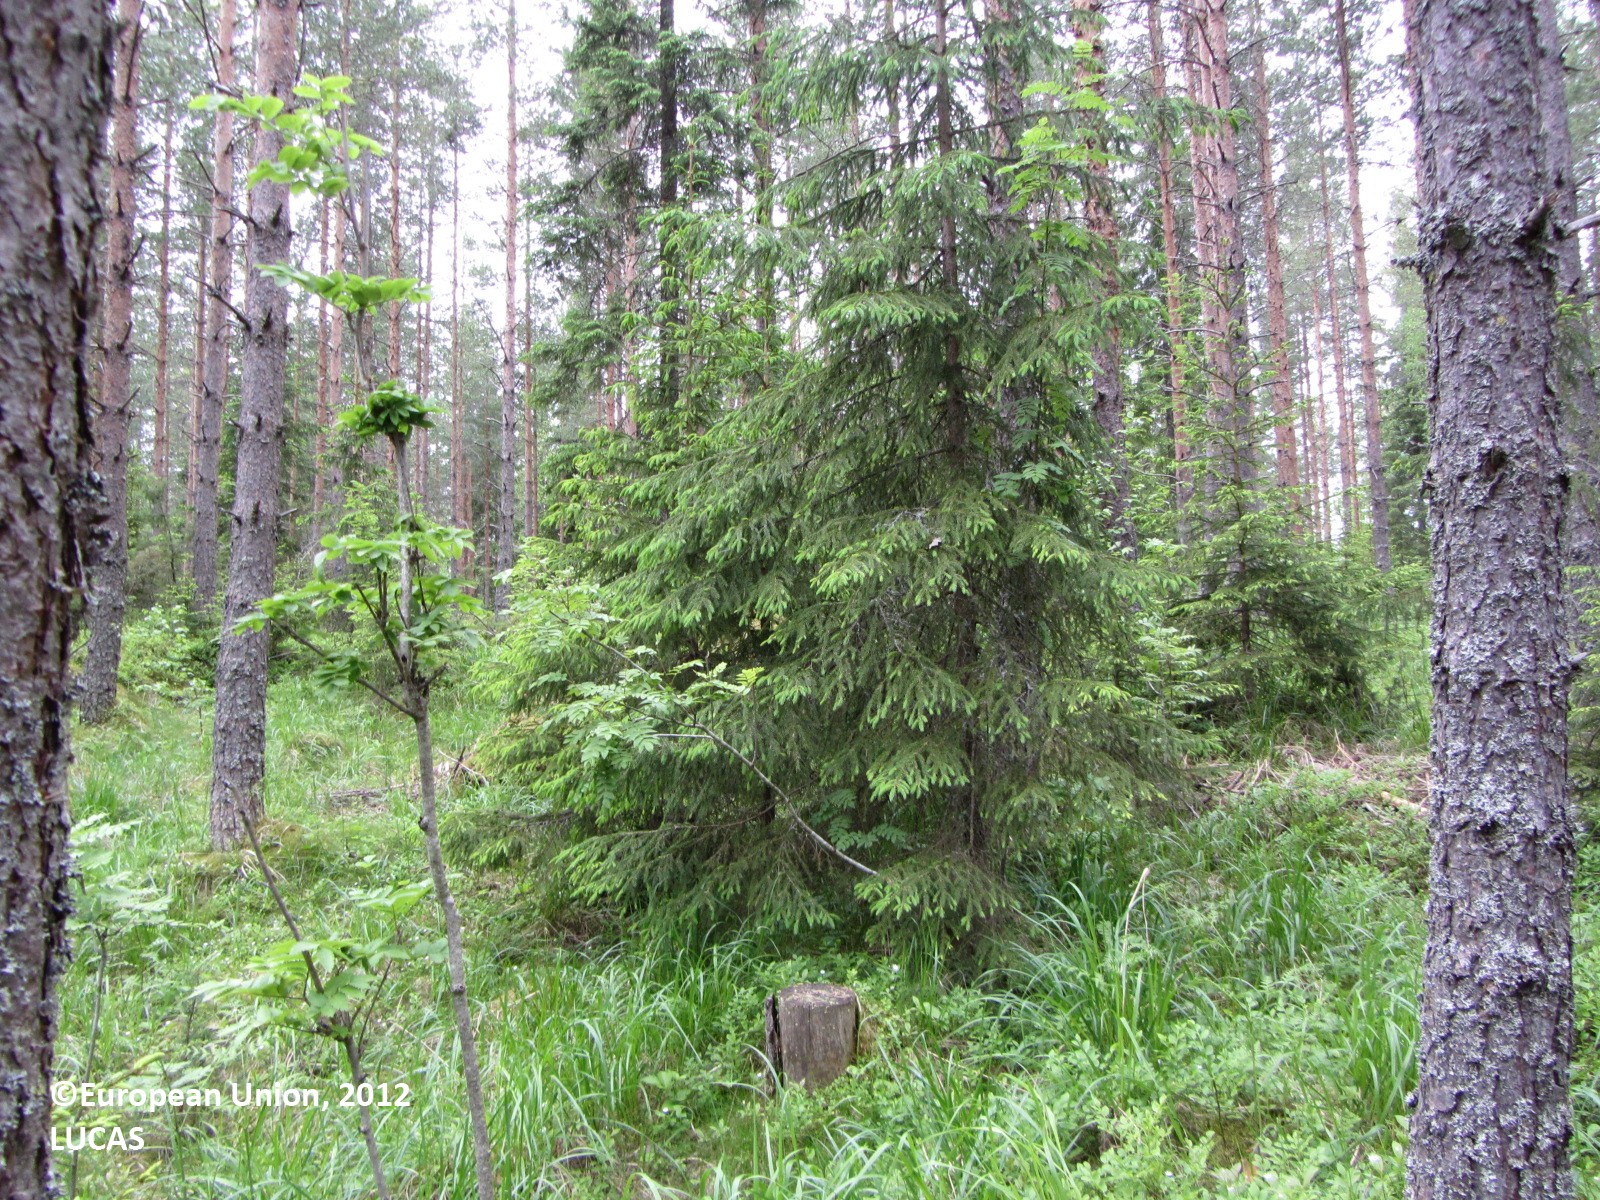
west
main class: Woodland
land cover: Other coniferous woodland
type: hemiboreal forest and nemoral coniferous forest and mixed broadleaved-coniferous forest
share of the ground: > 75 %
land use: Forestry
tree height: > 5 m
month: June
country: FI
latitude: 61.7394
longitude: 25.0460
